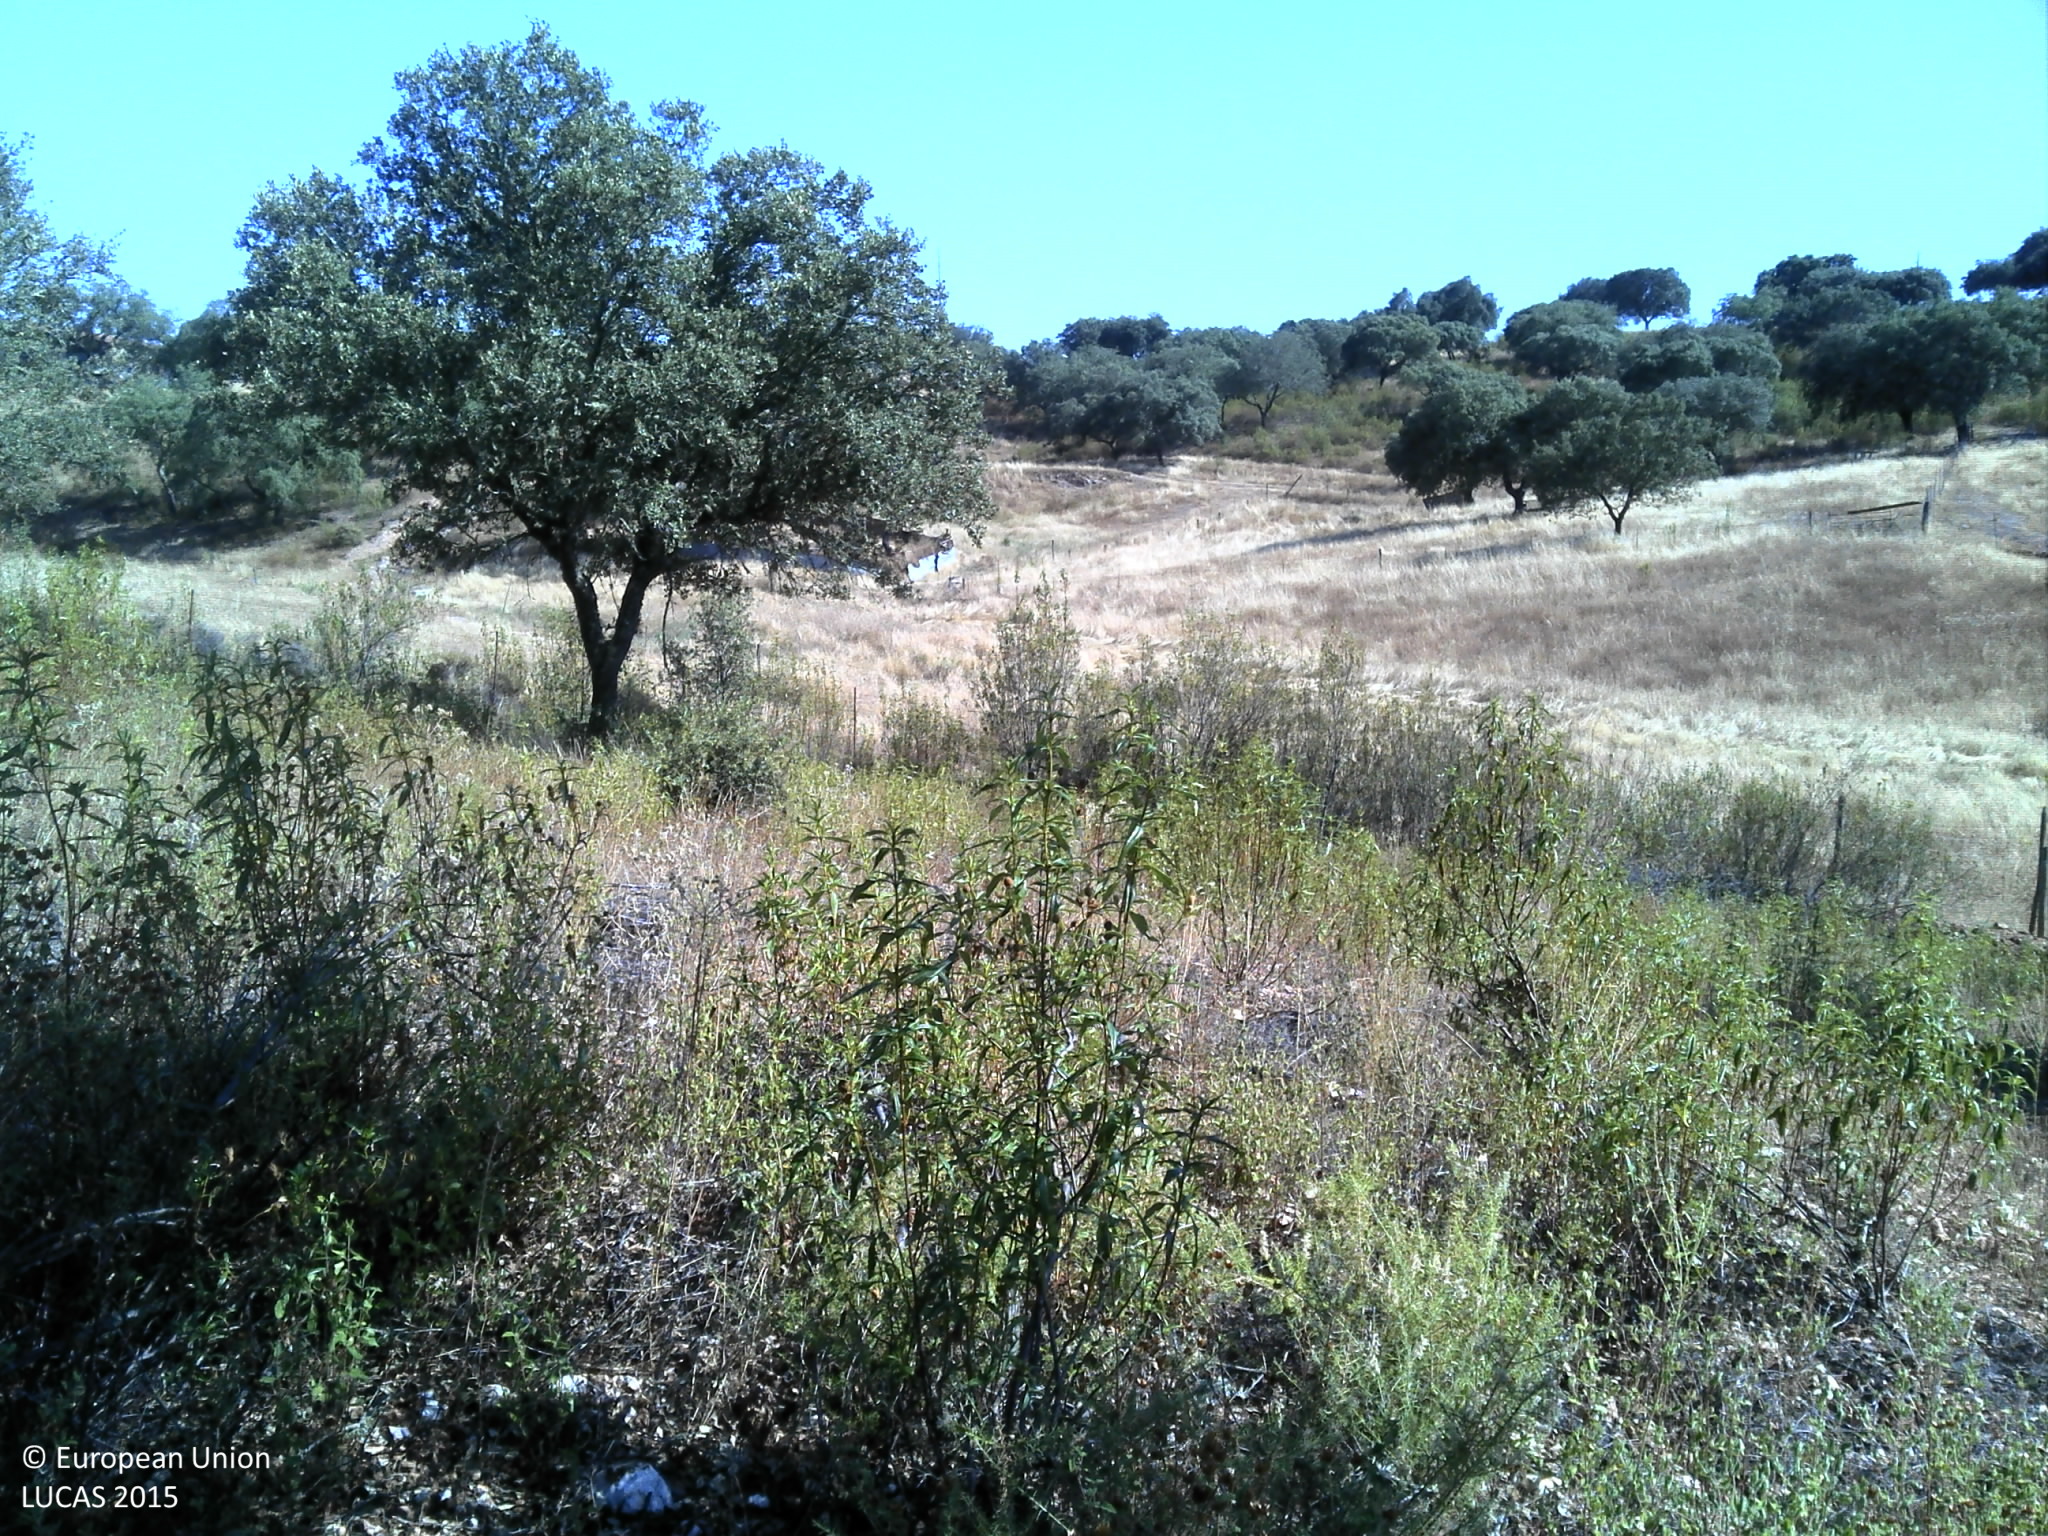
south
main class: Woodland
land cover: Broadleaved woodland
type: broadleaved evergreen forest
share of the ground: 50 - 75 %
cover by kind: broadleaved forest trees 70 %, shrubs 15 %, herbaceous plants 15 %
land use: Forestry
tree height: > 5 m
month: June
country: PT
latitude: 37.9203
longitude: -7.3159
